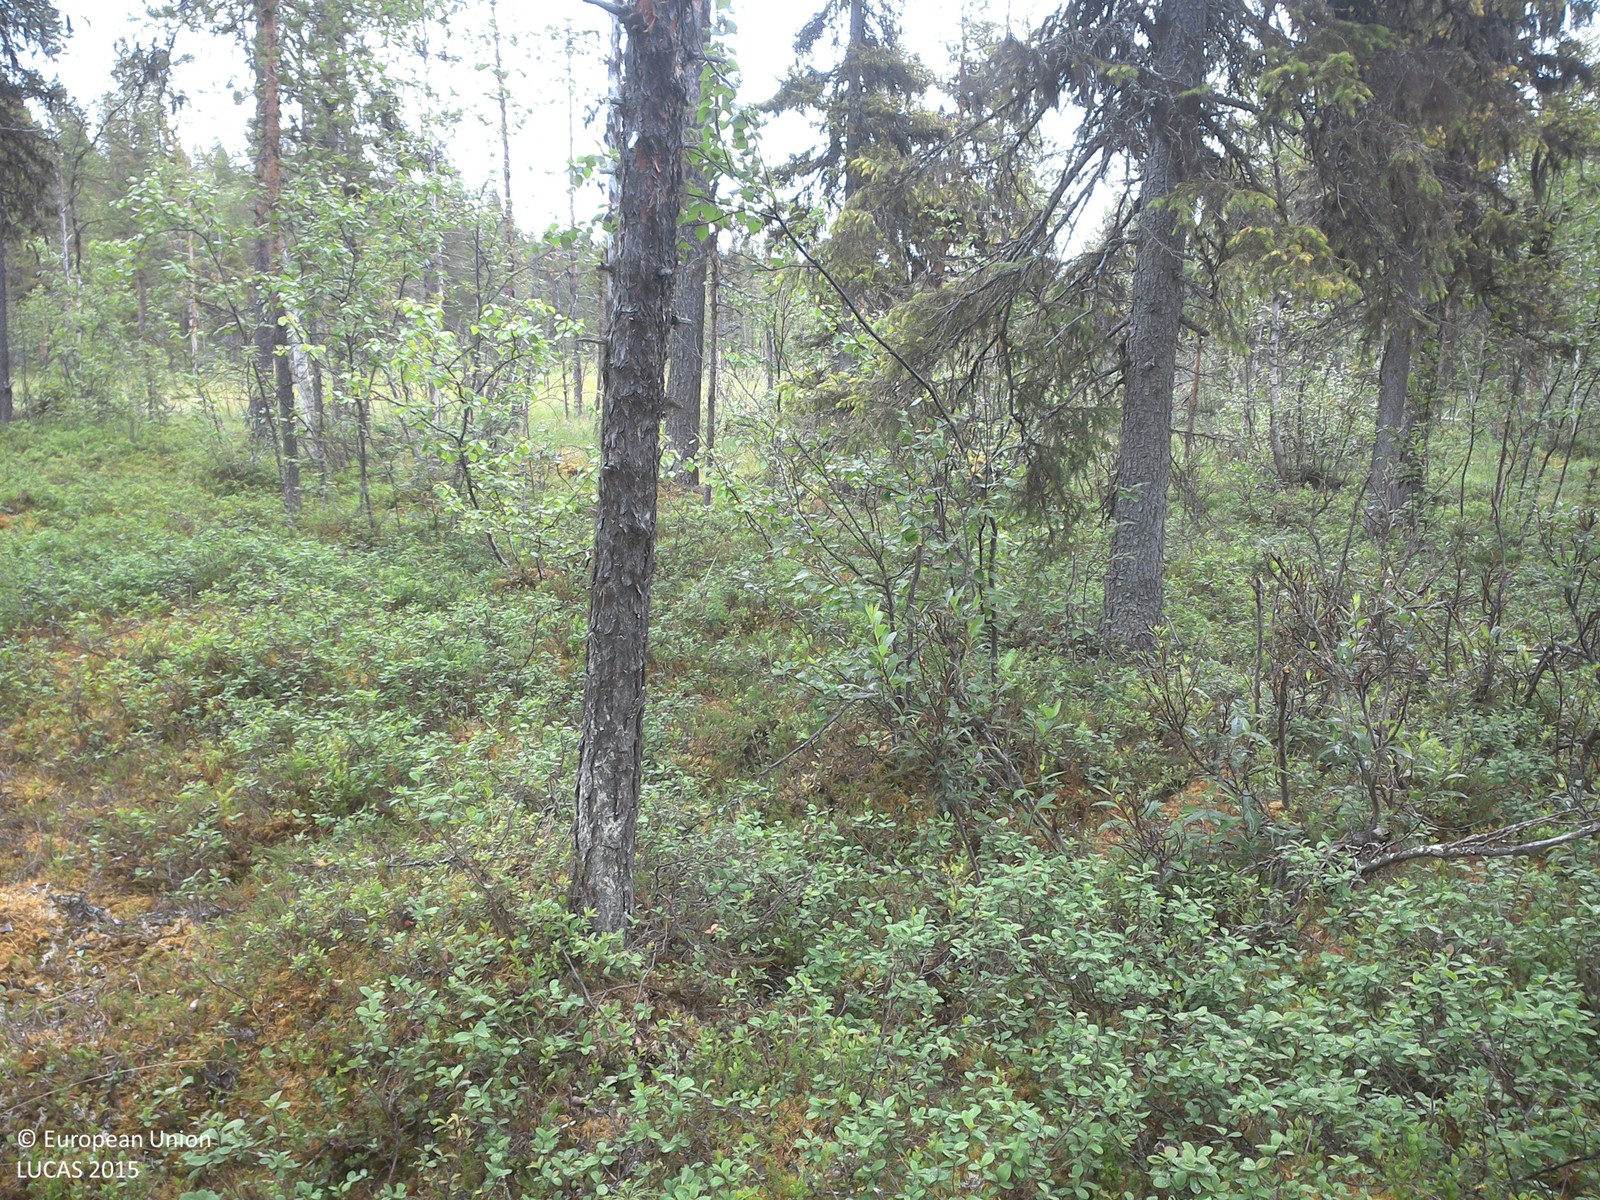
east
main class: Woodland
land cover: Pine dominated mixed woodland
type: boreal forest
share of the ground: 10 - 25 %
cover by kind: shrubs 70 %, coniferous forest trees 15 %, lichens and mosses 10 %, broadleaved forest trees 5 %
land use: Forestry
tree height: > 5 m
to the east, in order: Pine dominated mixed woodland; Peatbogs; Pine dominated mixed woodland; Pine dominated coniferous woodland
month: July
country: SE
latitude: 67.5364
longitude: 22.2676
